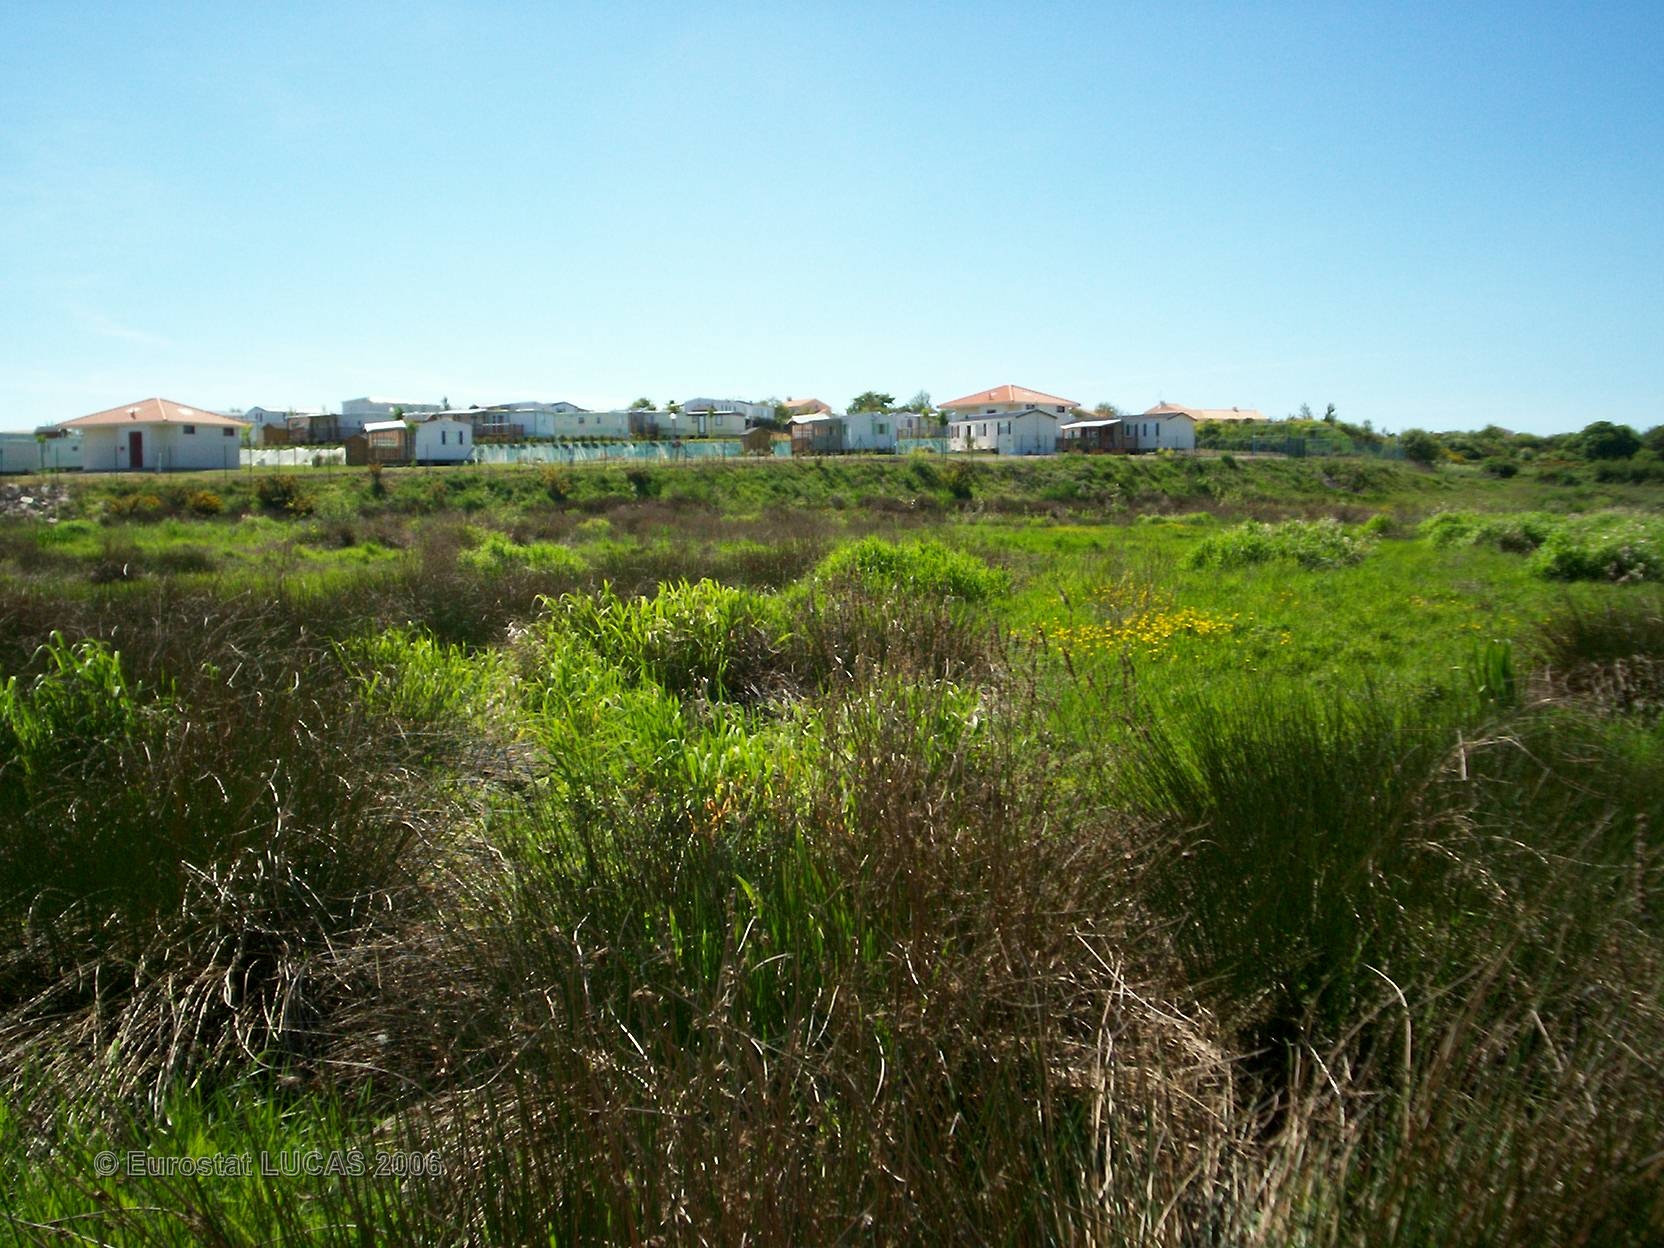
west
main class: Grassland
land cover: Grassland without tree/shrub cover
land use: Wetland
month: May
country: FR
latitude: 47.1668
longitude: -2.1472
